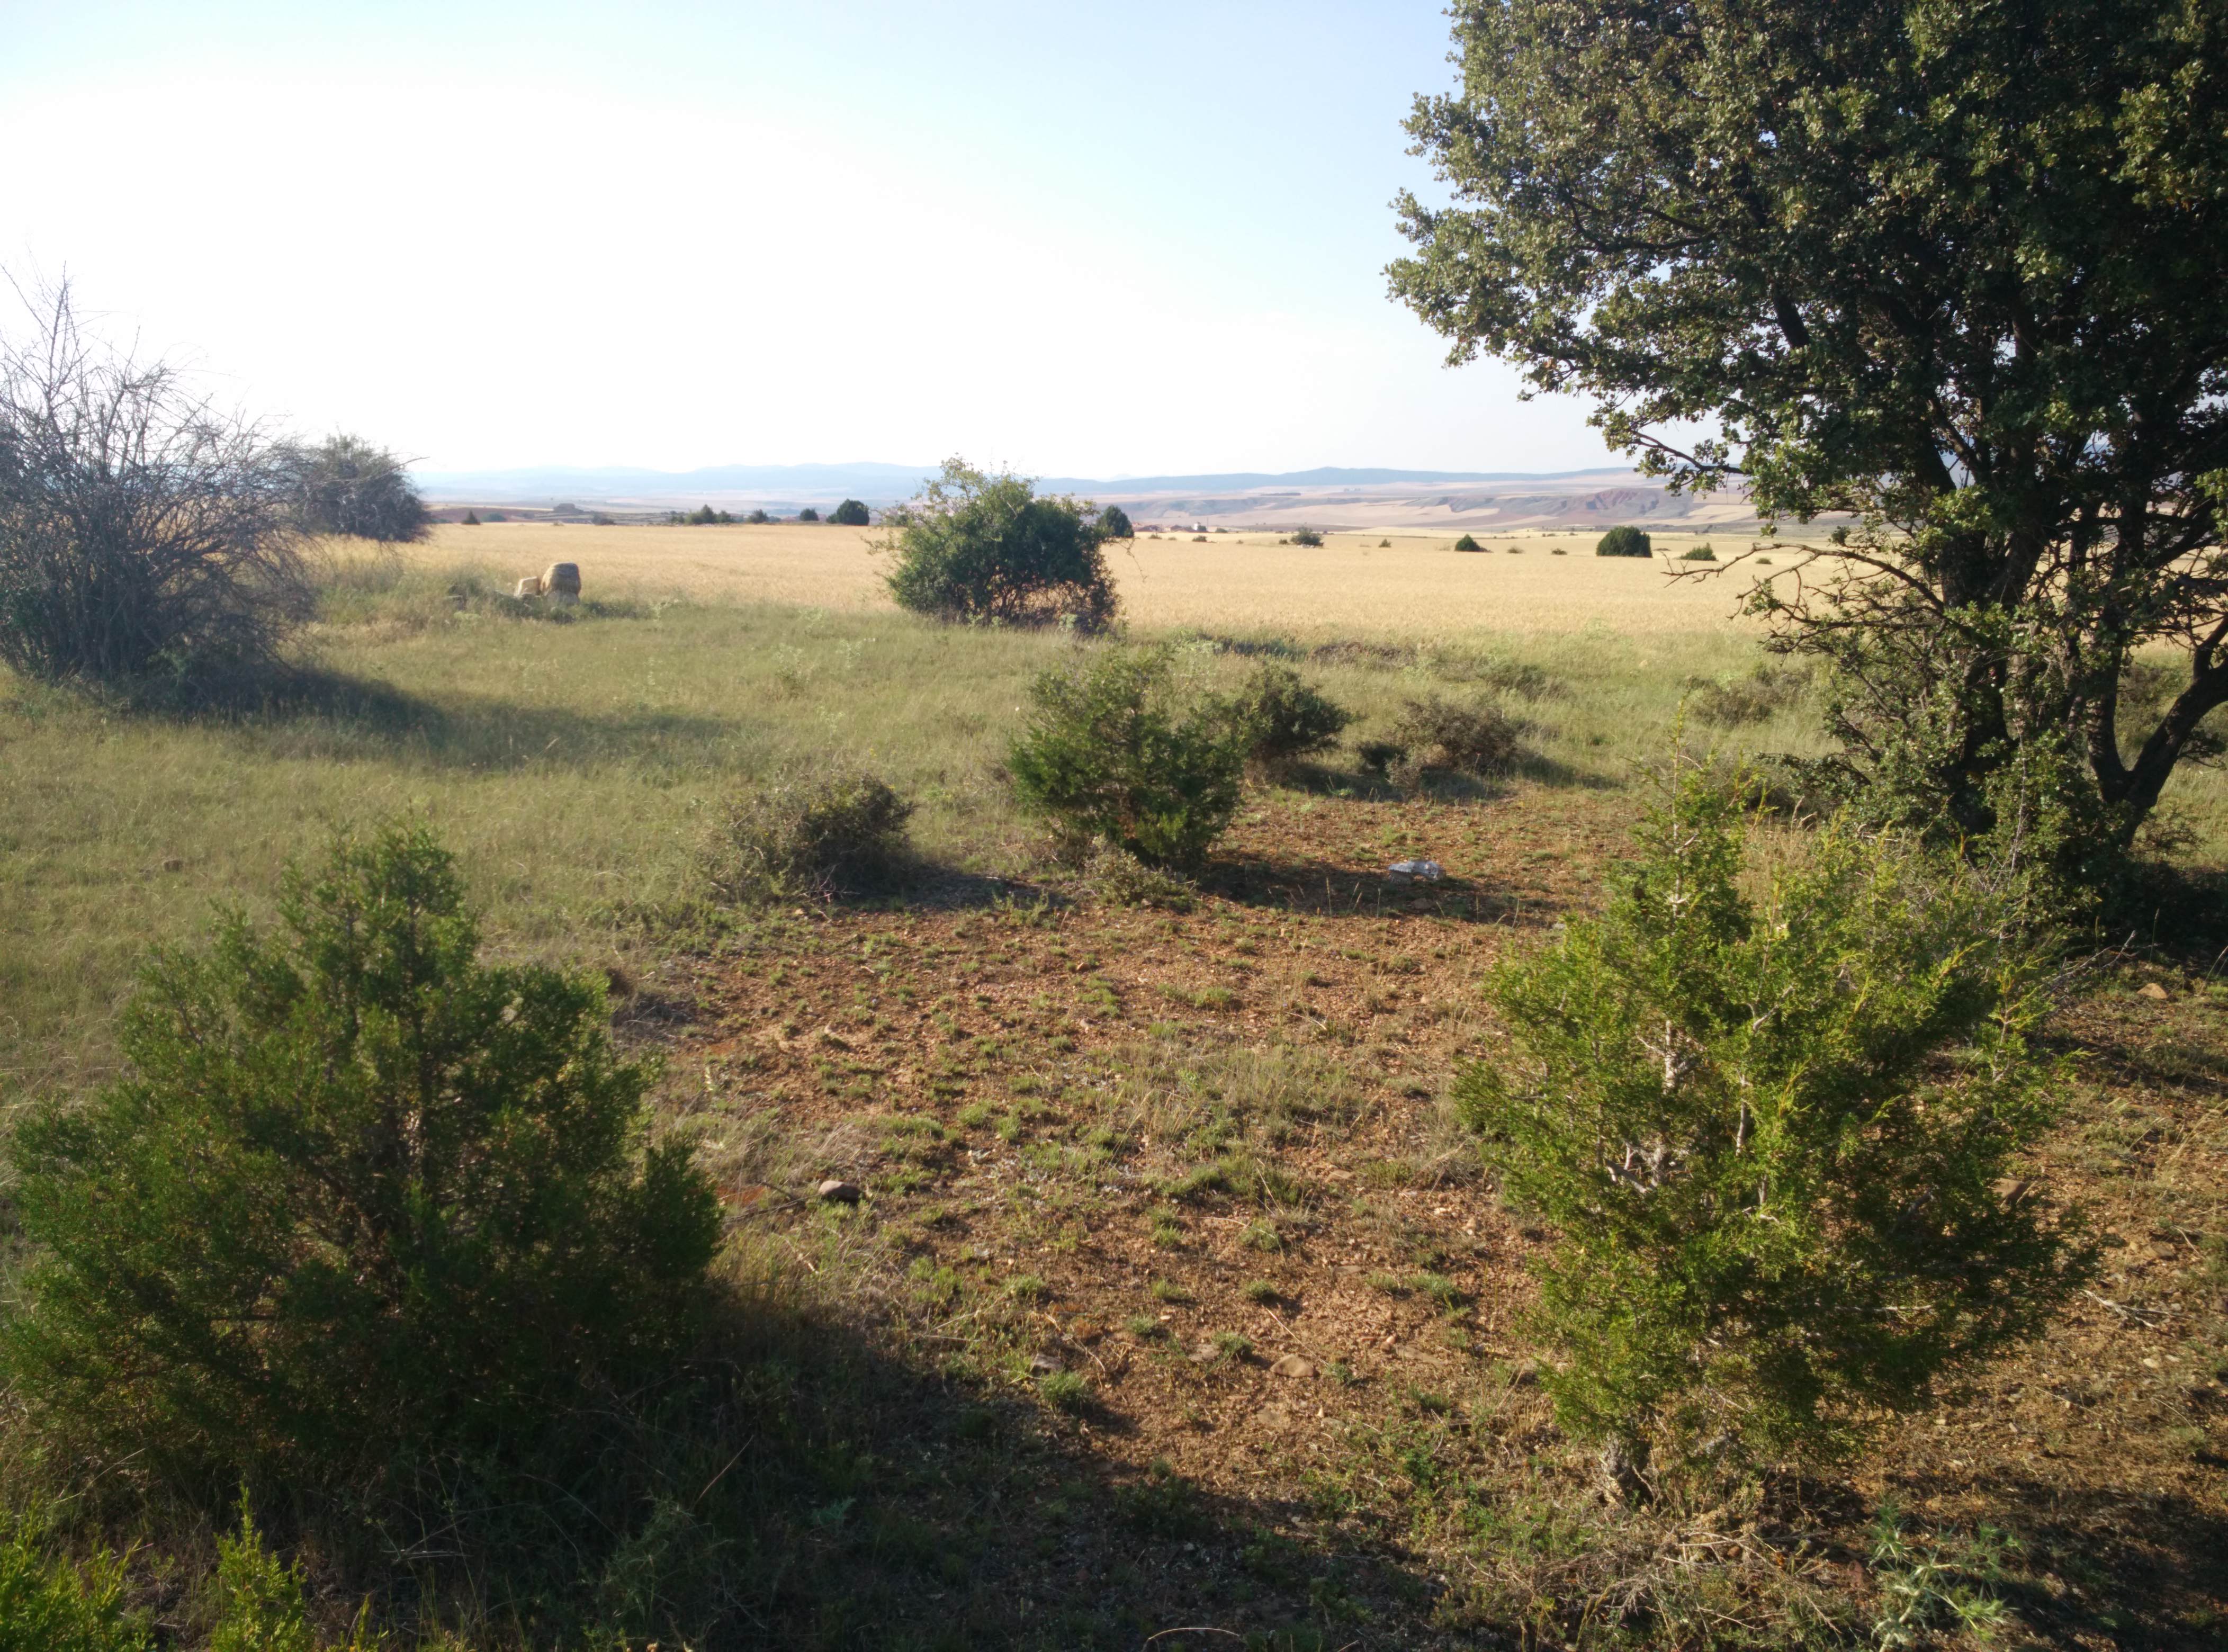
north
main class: Grassland
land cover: Grassland with sparse tree/shrub cover
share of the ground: 25 - 50 %
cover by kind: unconsolidated bare surface 50 %, herbaceous plants 40 %, broadleaved forest trees 5 %, shrubs 5 %
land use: Semi-natural and natural areas not in use
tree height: < 5 m
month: June
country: ES
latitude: 40.7391
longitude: -1.8030
